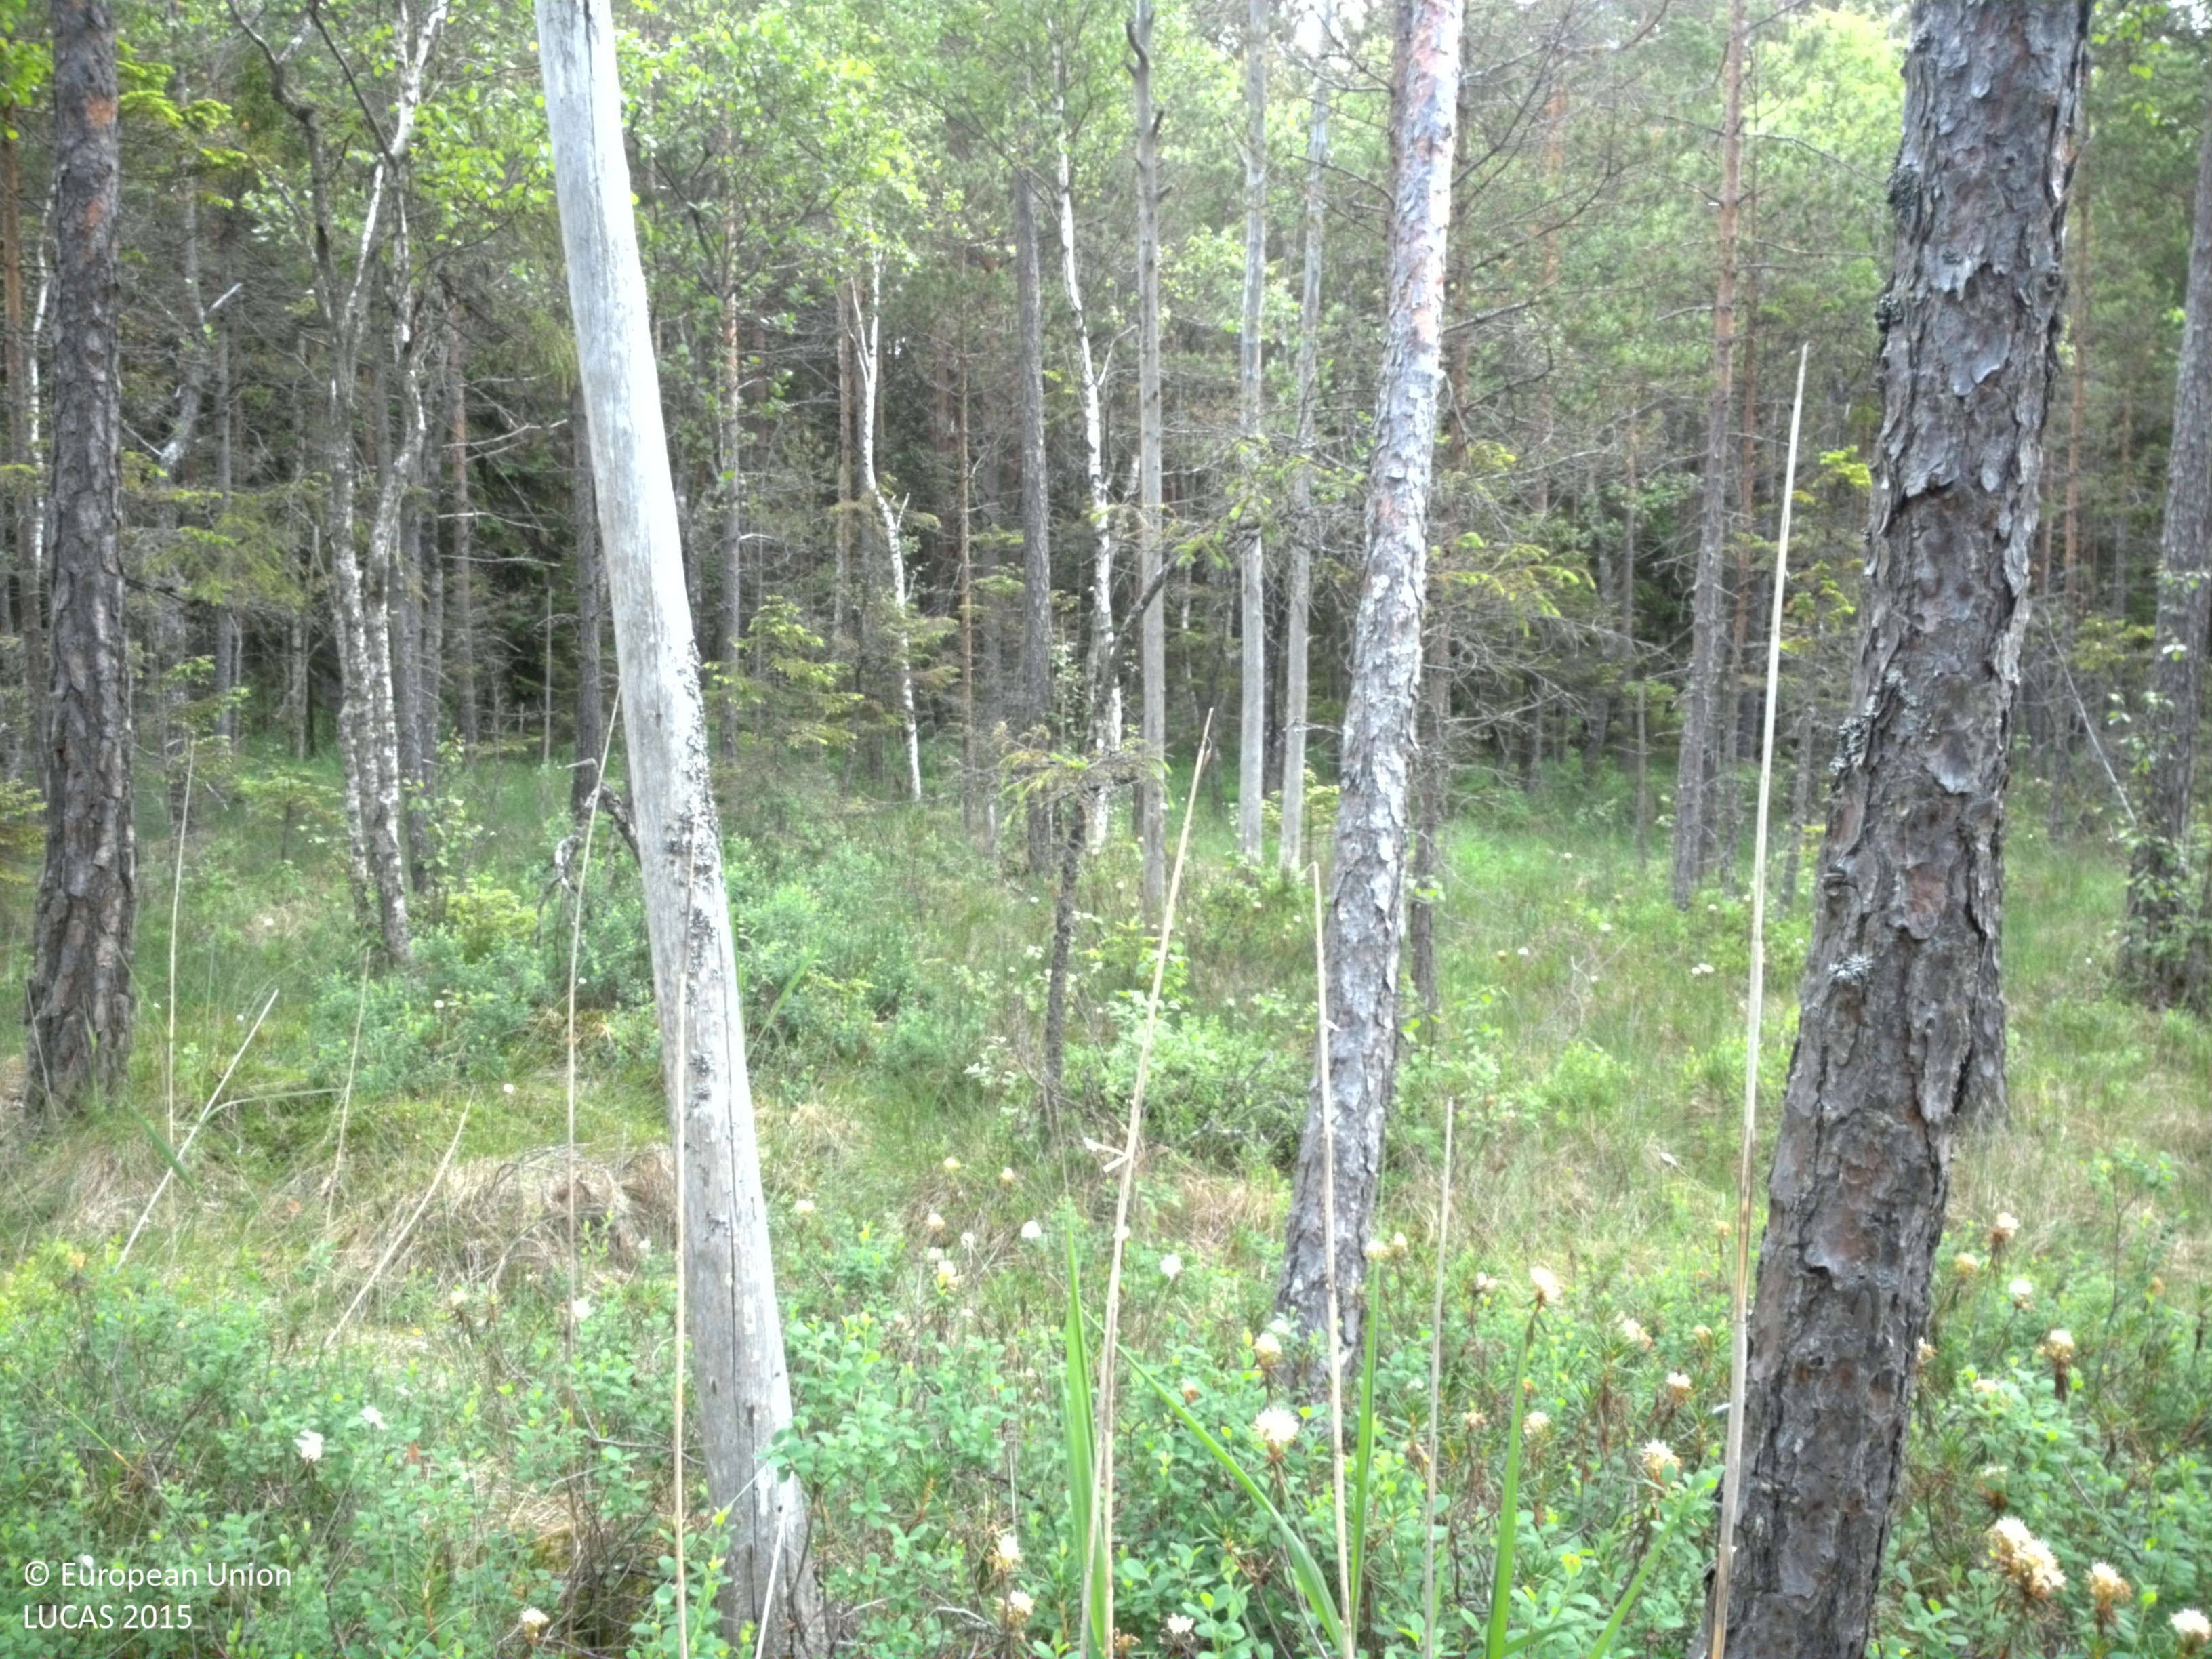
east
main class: Woodland
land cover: Pine dominated coniferous woodland
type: boreal forest
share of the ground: 25 - 50 %
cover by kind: coniferous forest trees 45 %, herbaceous plants 25 %, lichens and mosses 25 %, broadleaved forest trees 5 %
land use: Forestry
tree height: > 5 m
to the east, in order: Pine dominated coniferous woodland
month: June
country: SE
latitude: 59.9458
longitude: 17.1348
